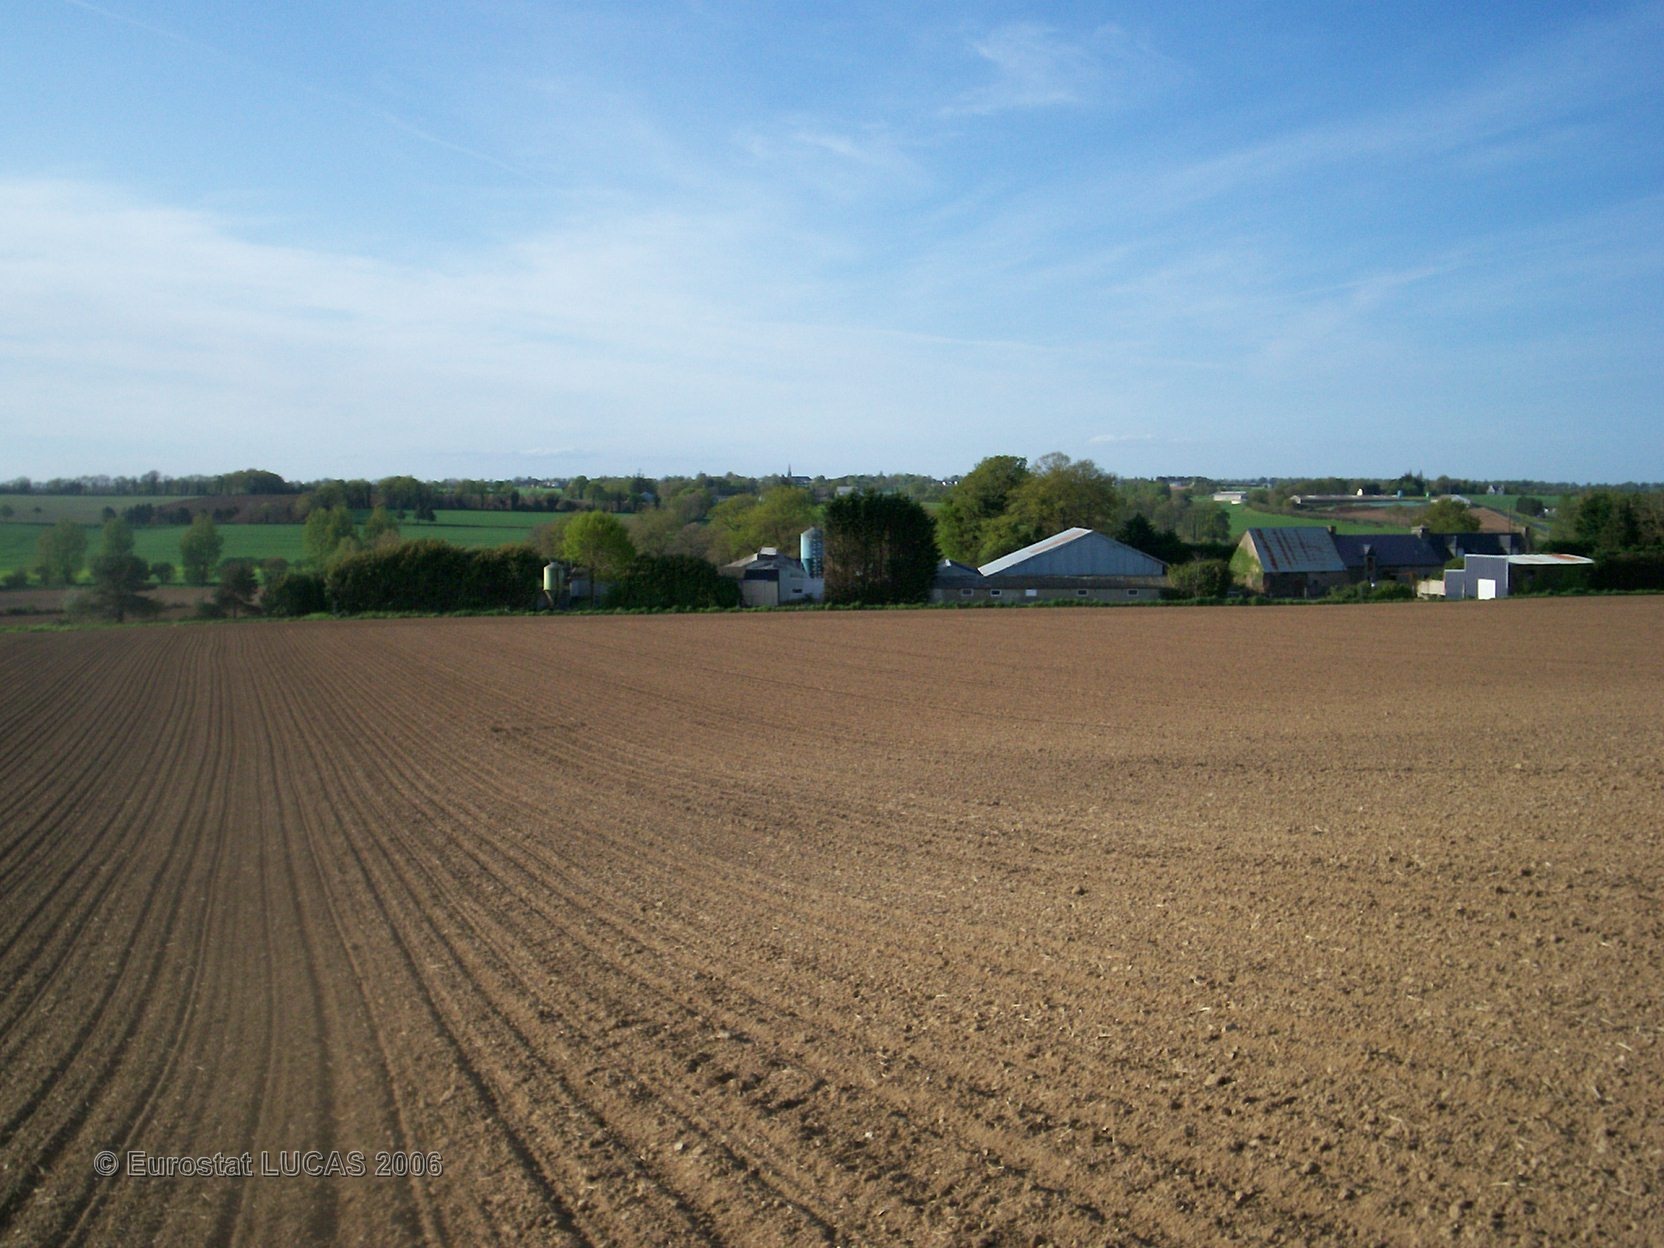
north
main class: Cropland
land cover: Maize
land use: Agriculture (excluding fallow land and kitchen gardens)
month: May
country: FR
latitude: 47.9622
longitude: -2.8280
